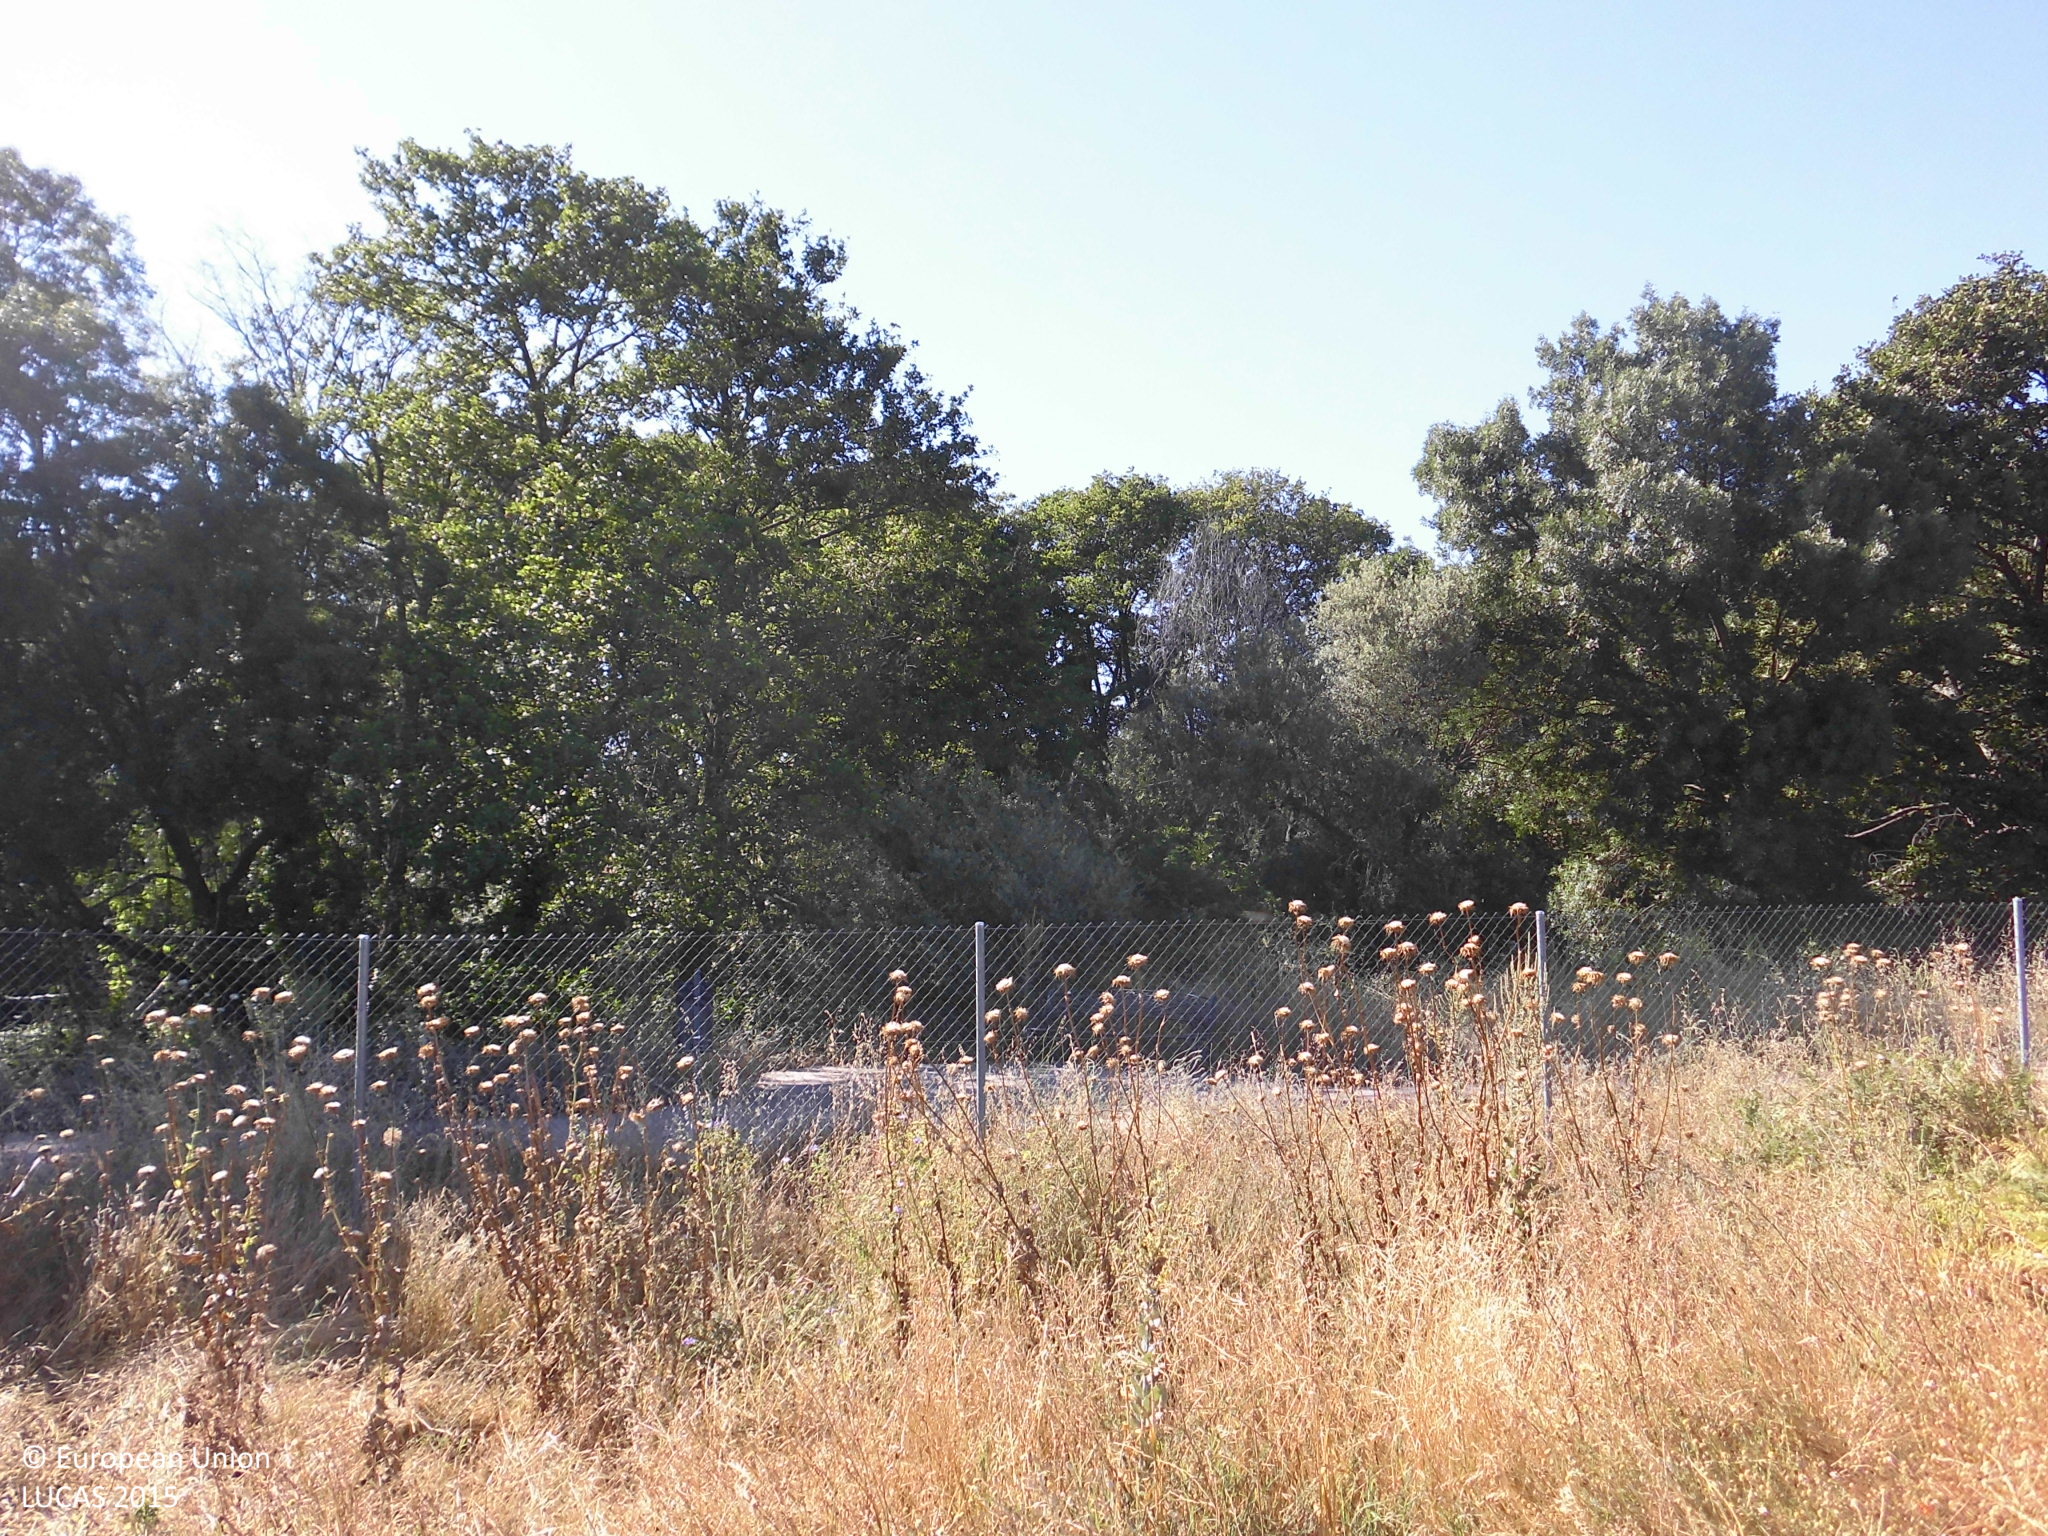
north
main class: Cropland
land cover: Oats
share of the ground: 50 - 75 %
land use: Agriculture (excluding fallow land and kitchen gardens)
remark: Harvested field
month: June
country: ES
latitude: 40.0373
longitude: -6.0685
